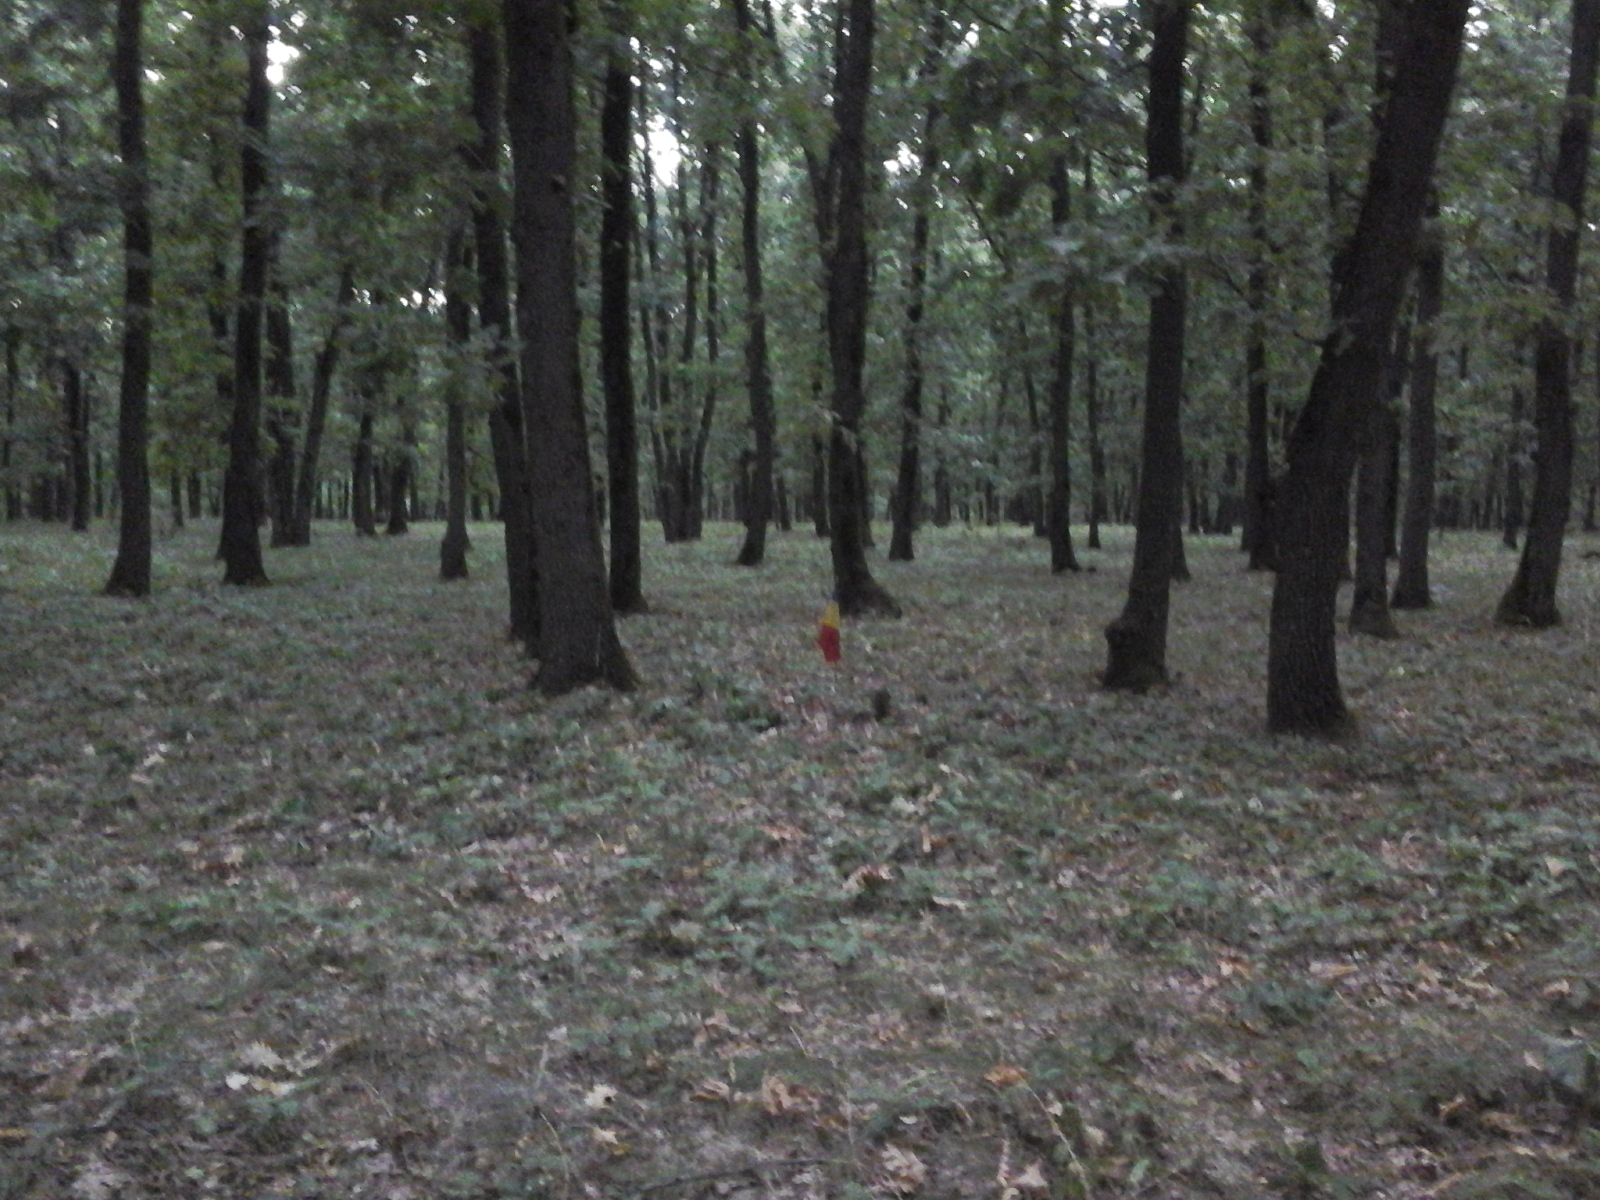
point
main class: Woodland
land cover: Broadleaved woodland
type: acidophilous oak and oak-birch forest
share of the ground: > 75 %
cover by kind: broadleaved forest trees 100 %
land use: Forestry
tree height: > 5 m
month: August
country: RO
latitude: 44.3536
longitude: 23.2588
